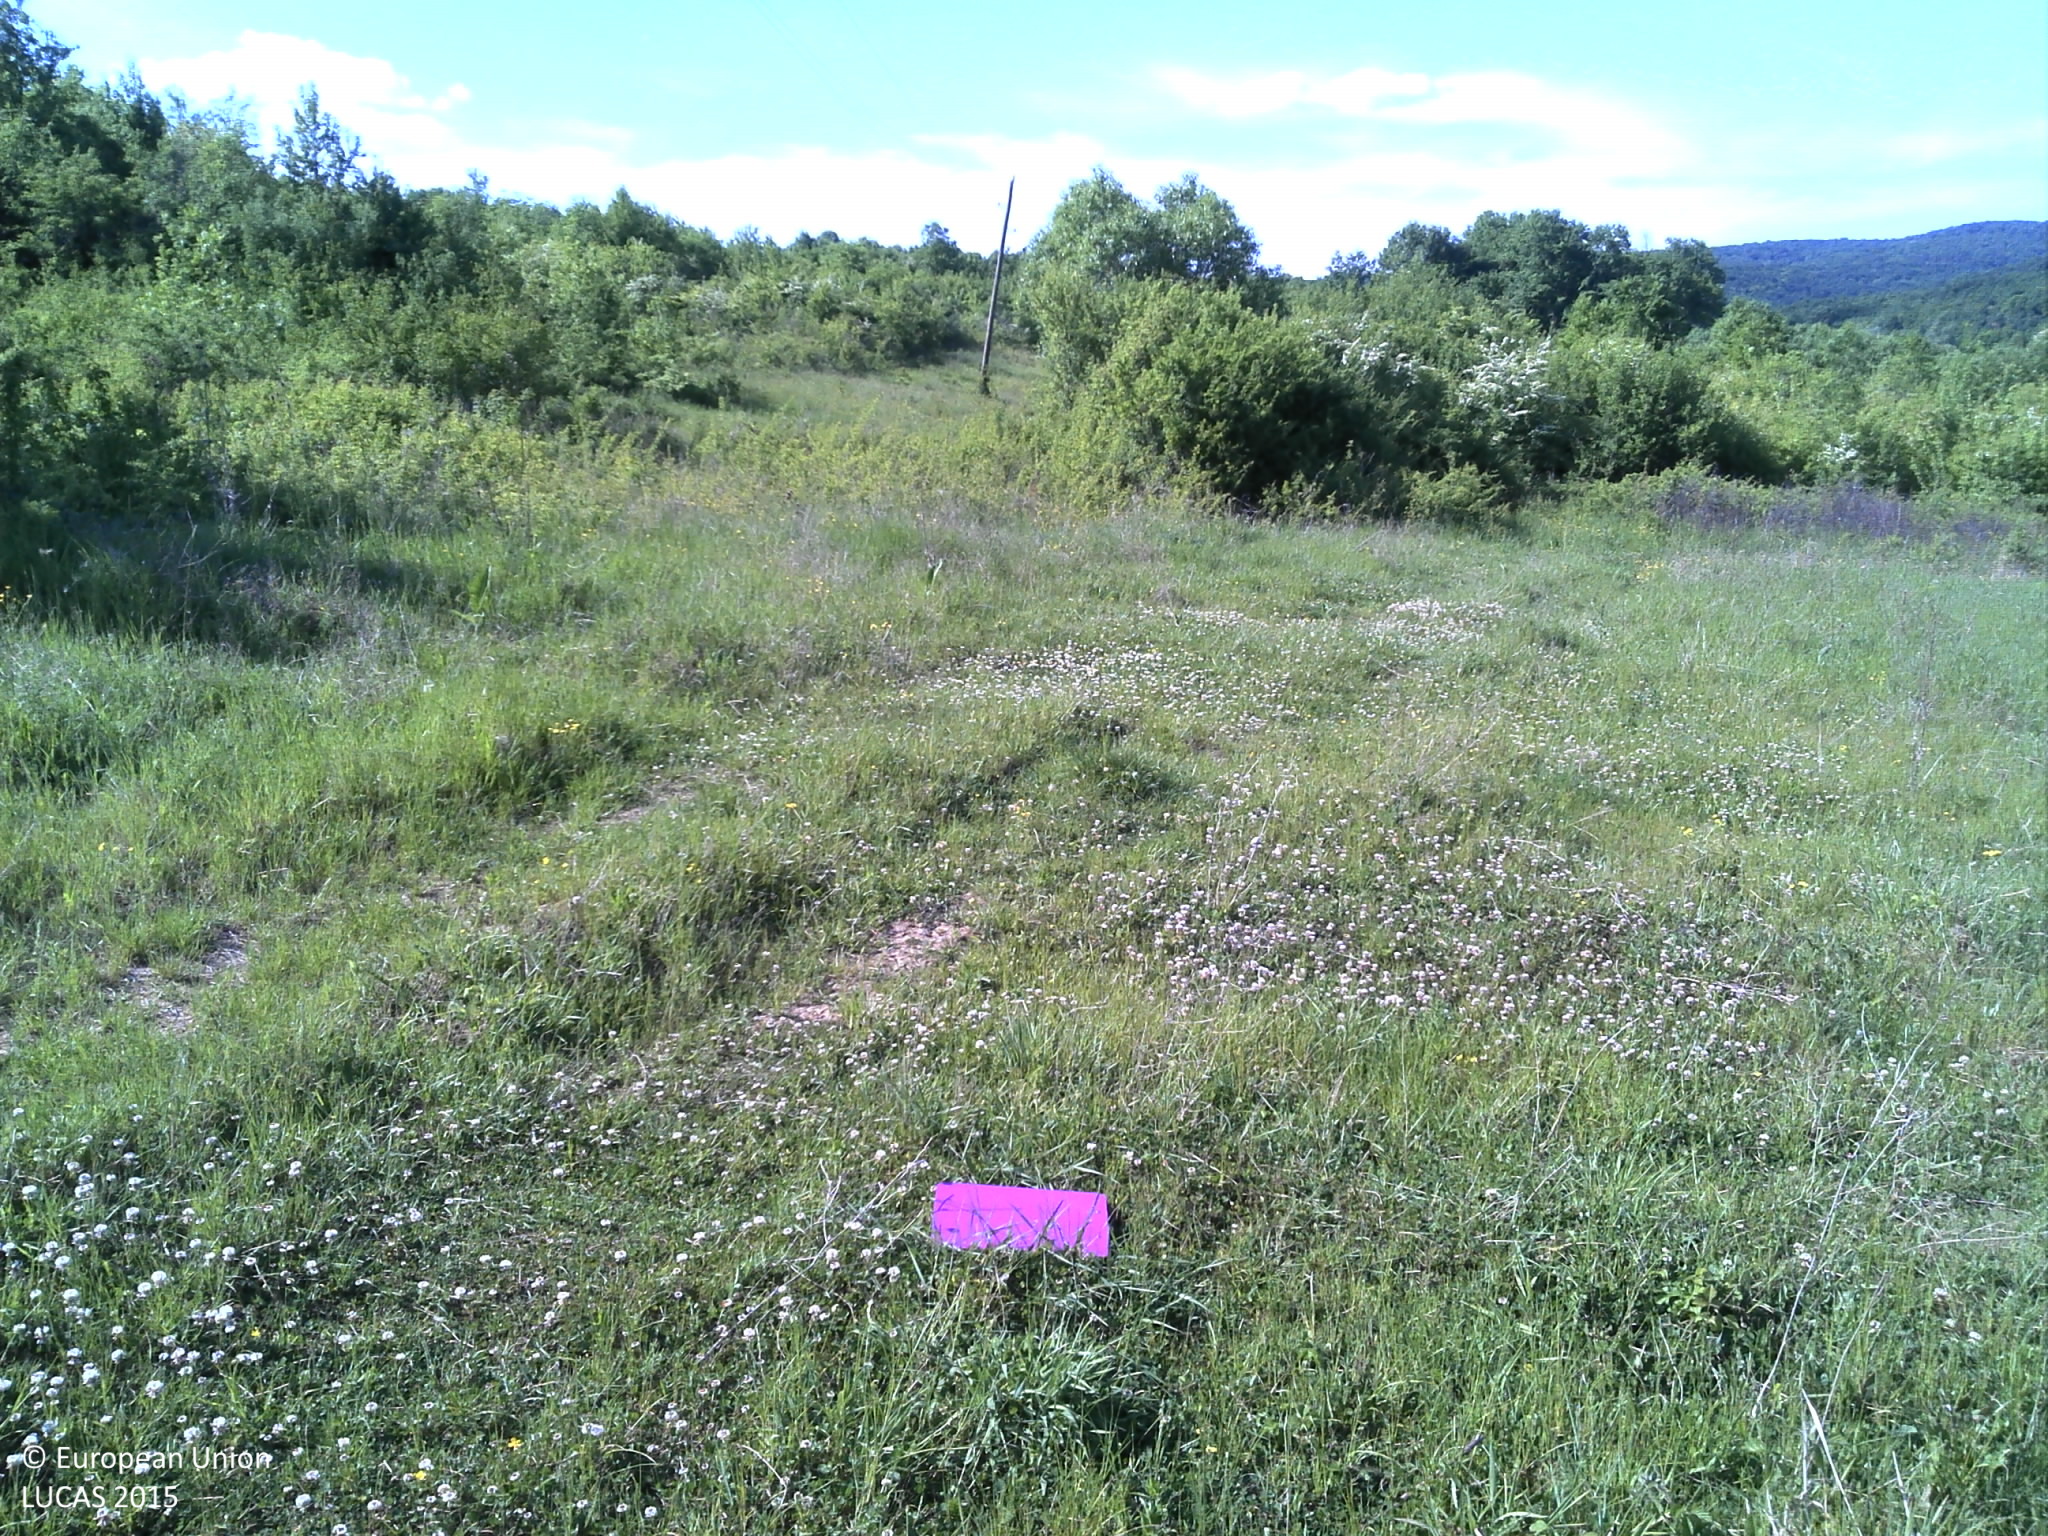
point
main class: Cropland
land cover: Clovers
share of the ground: > 75 %
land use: Agriculture (excluding fallow land and kitchen gardens)
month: May
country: HR
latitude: 45.2297
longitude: 18.0910
